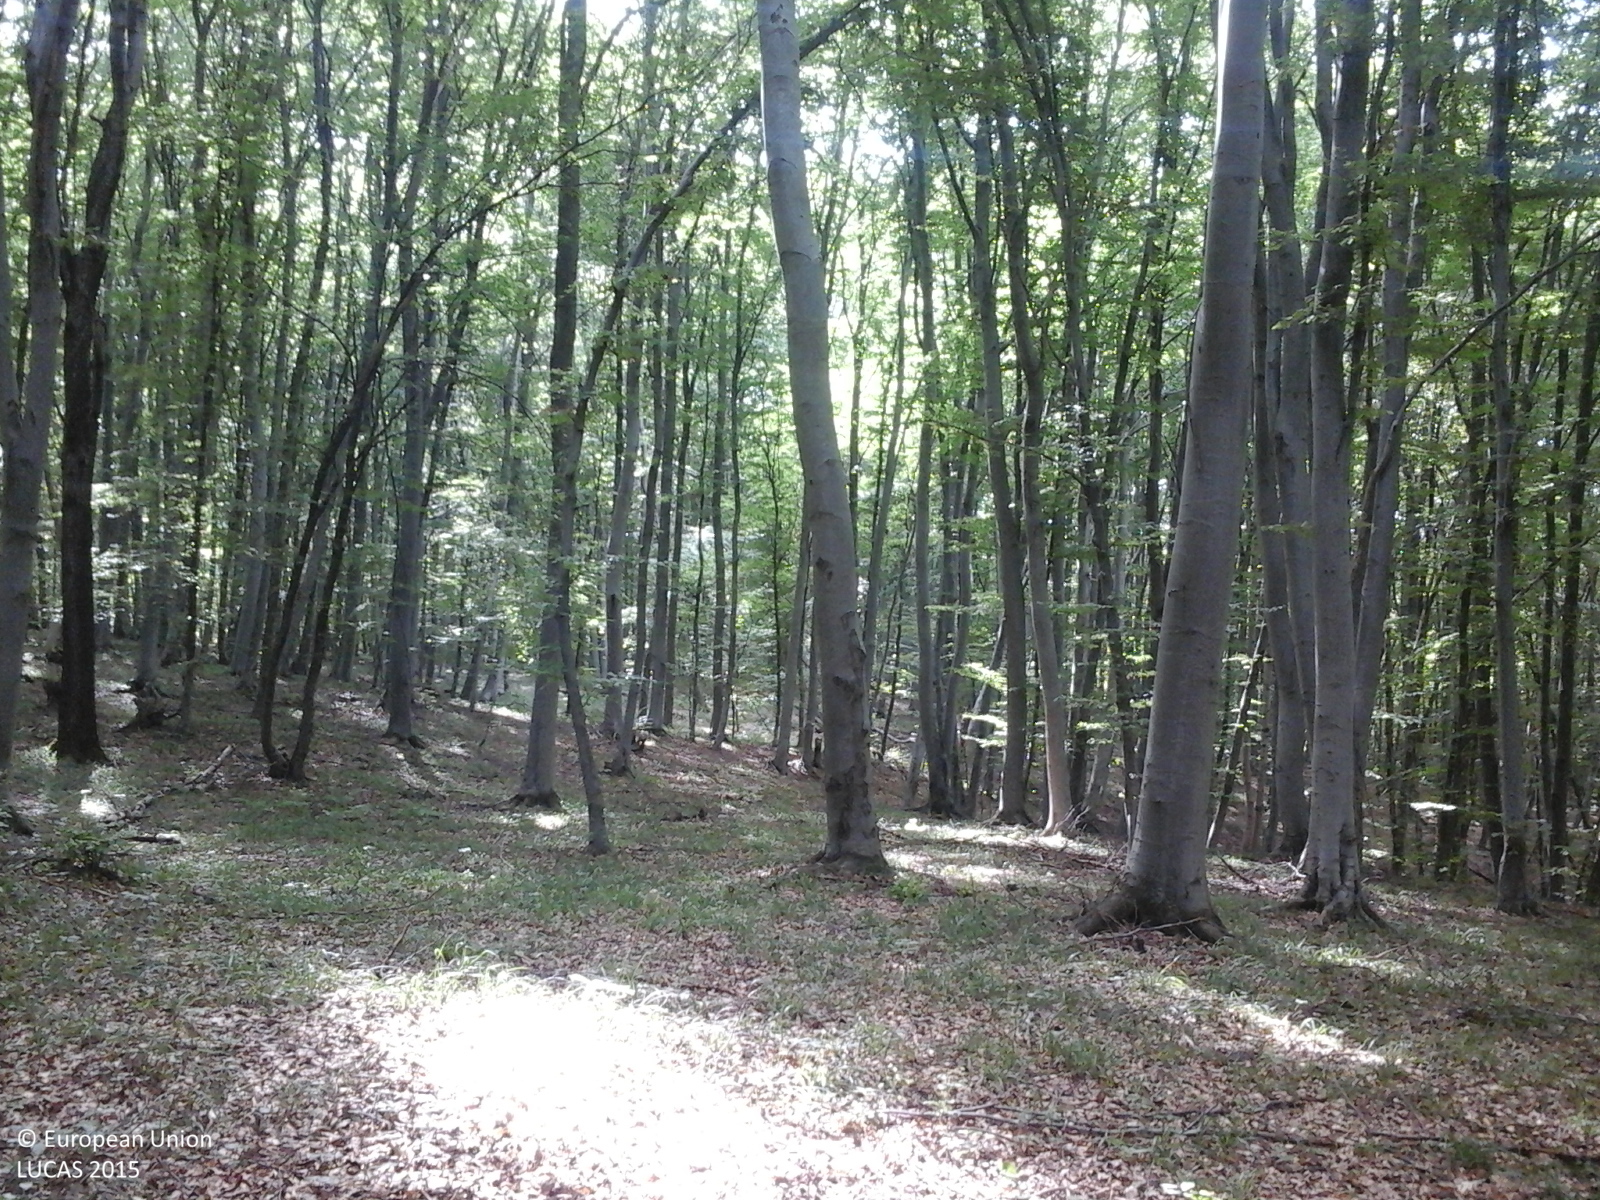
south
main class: Woodland
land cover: Broadleaved woodland
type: beech forest
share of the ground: > 75 %
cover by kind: broadleaved forest trees 100 %
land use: Forestry
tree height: > 5 m
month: September
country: RO
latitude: 46.7064
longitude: 23.5552
